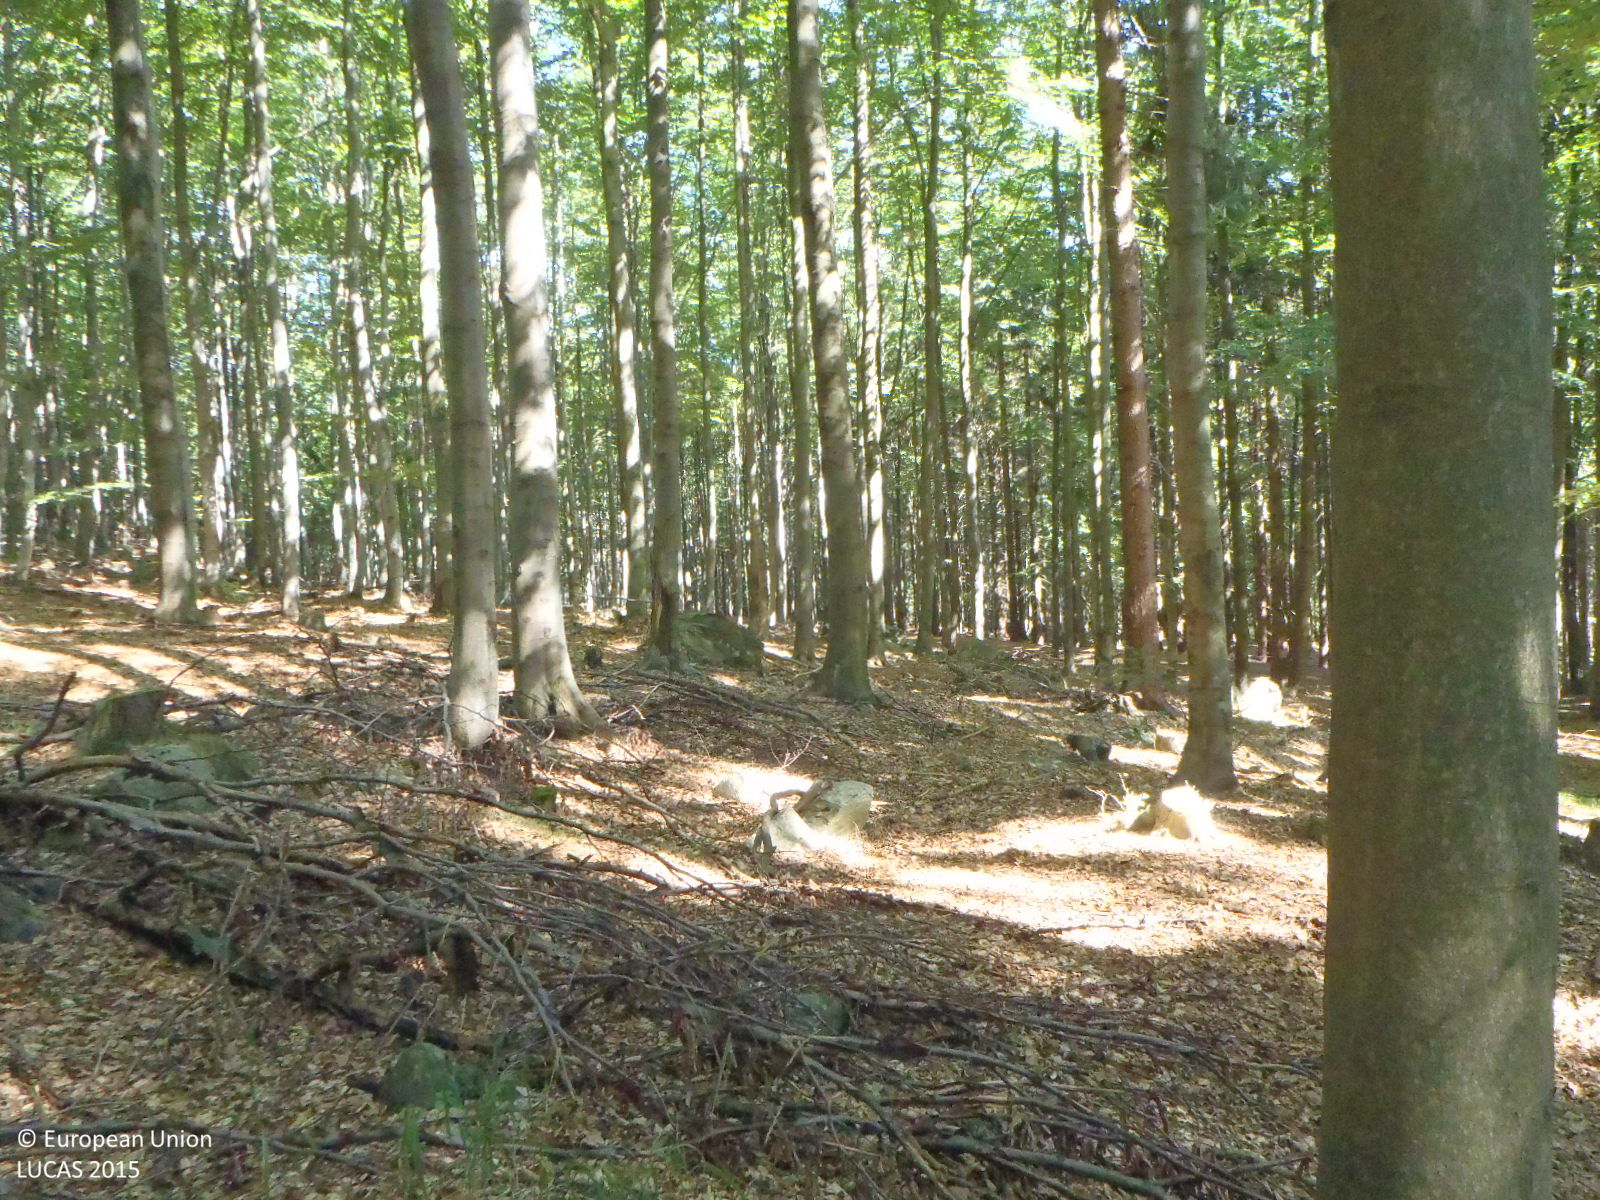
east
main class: Woodland
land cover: Other mixed woodland
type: hemiboreal forest and nemoral coniferous forest and mixed broadleaved-coniferous forest
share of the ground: > 75 %
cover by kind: broadleaved forest trees 60 %, coniferous forest trees 40 %
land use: Forestry
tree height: > 5 m
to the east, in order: Other mixed woodland; Broadleaved woodland; Tracks; Broadleaved woodland; Spruce dominated coniferous woodland; Rock outcrops; Other mixed woodland
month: August
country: CZ
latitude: 50.8124
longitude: 14.5862
